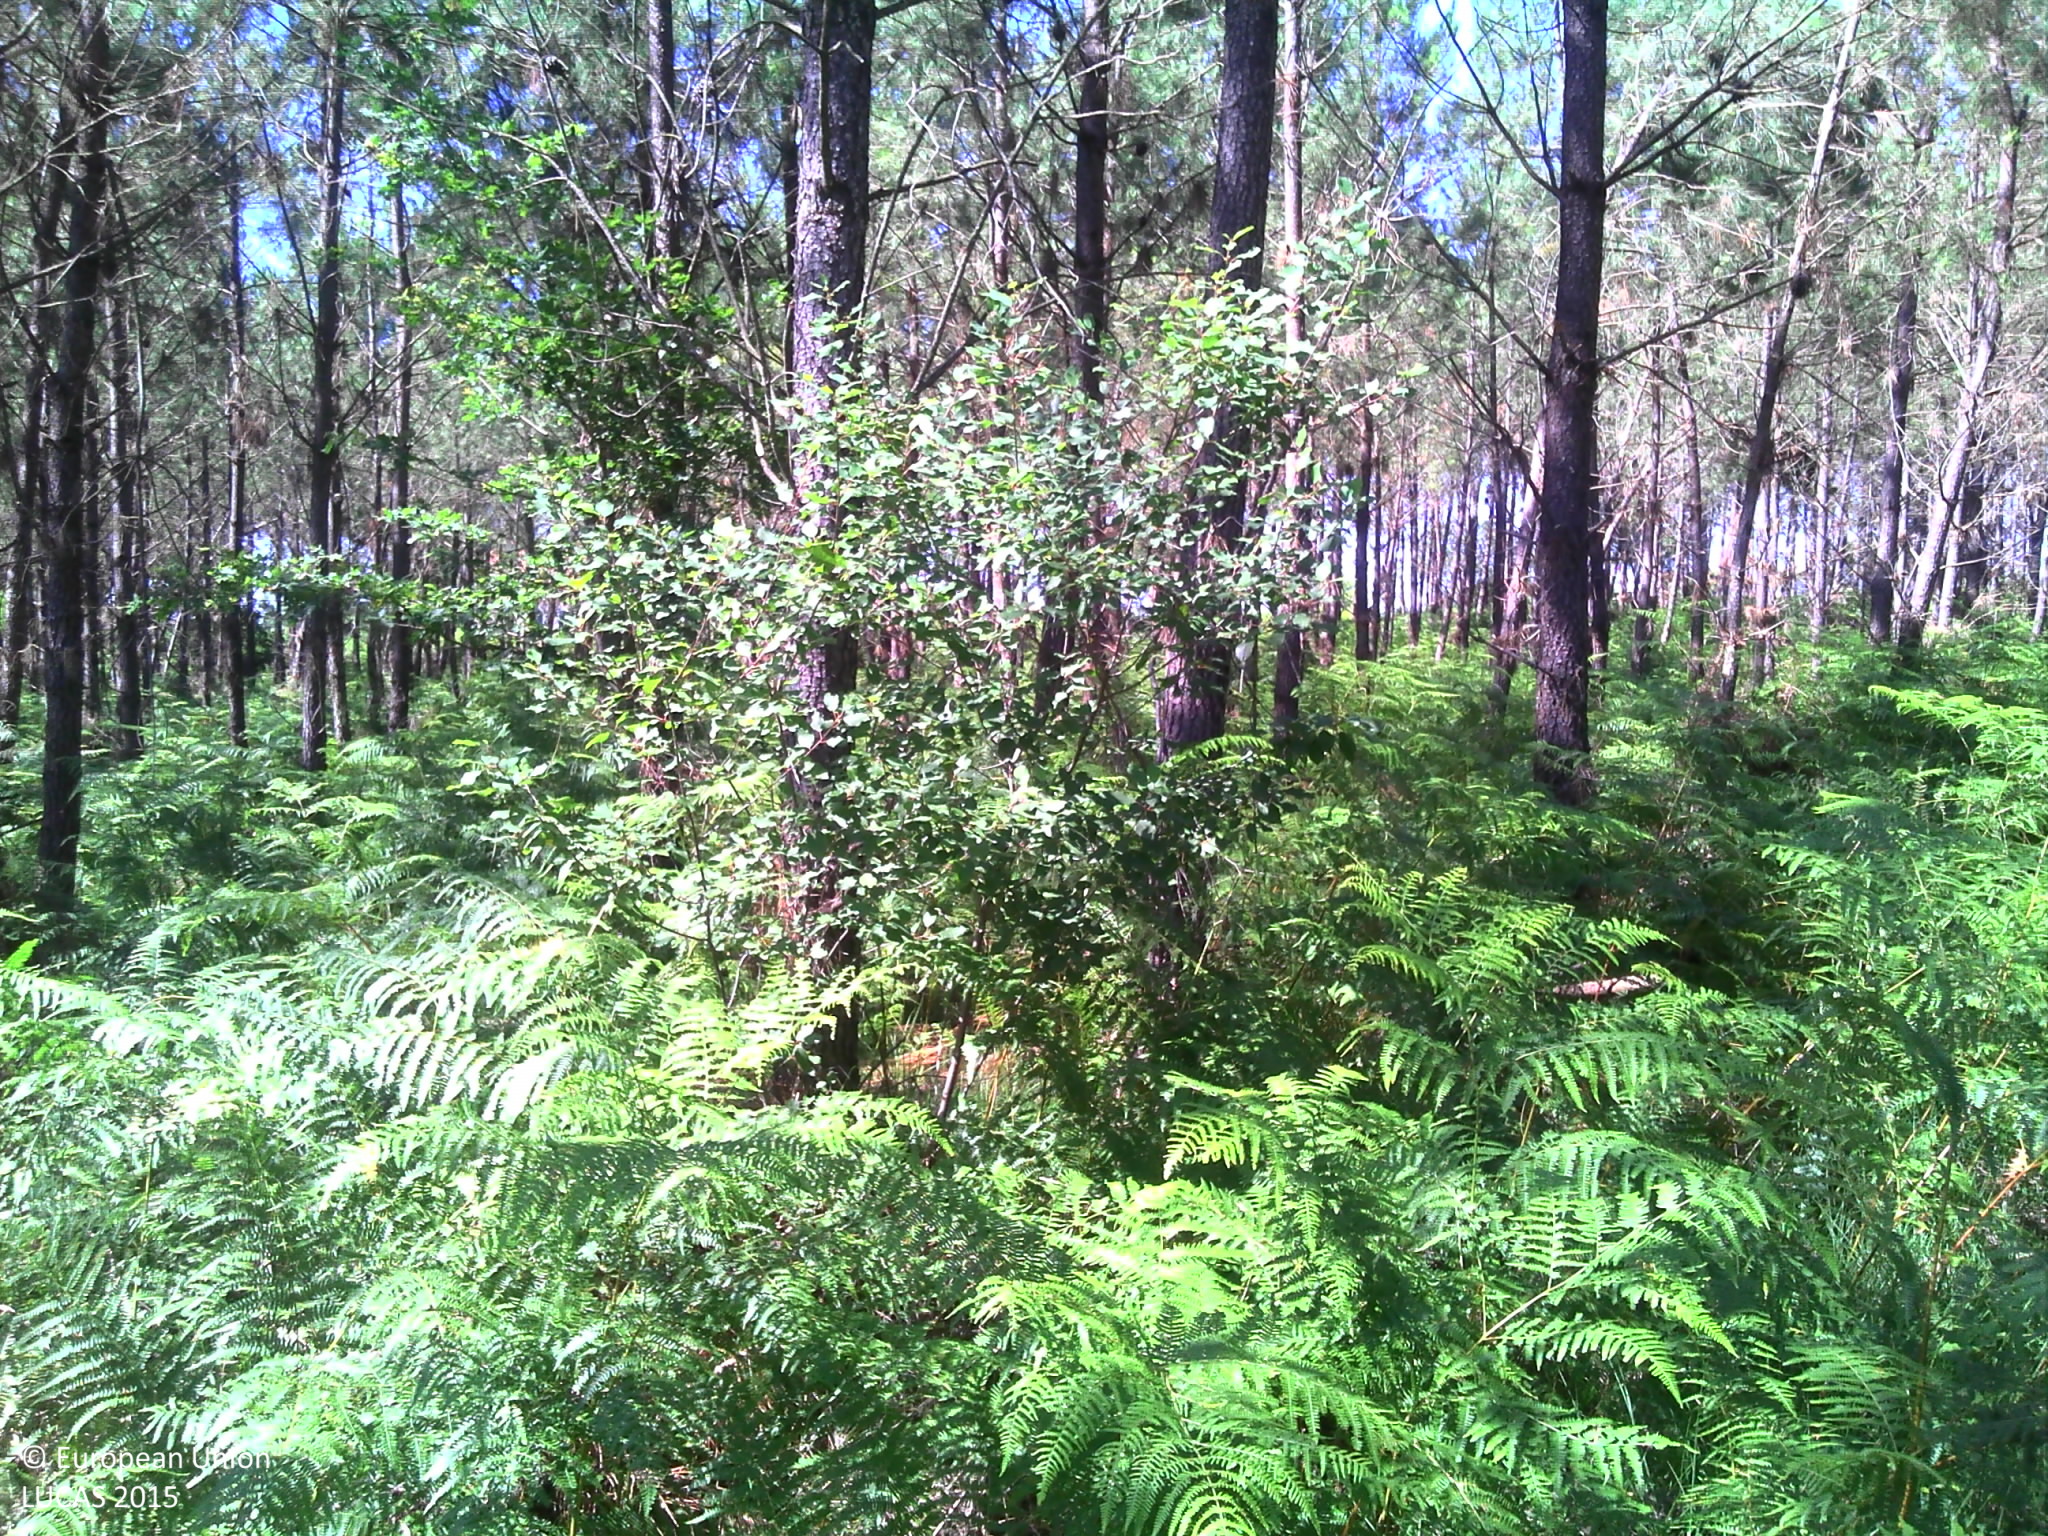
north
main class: Woodland
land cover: Pine dominated coniferous woodland
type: coniferous forest of the mediterranean region
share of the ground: > 75 %
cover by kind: coniferous forest trees 85 %, herbaceous plants 10 %, shrubs 5 %
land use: Forestry
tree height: > 5 m
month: July
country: FR
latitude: 43.9956
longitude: -0.5250
